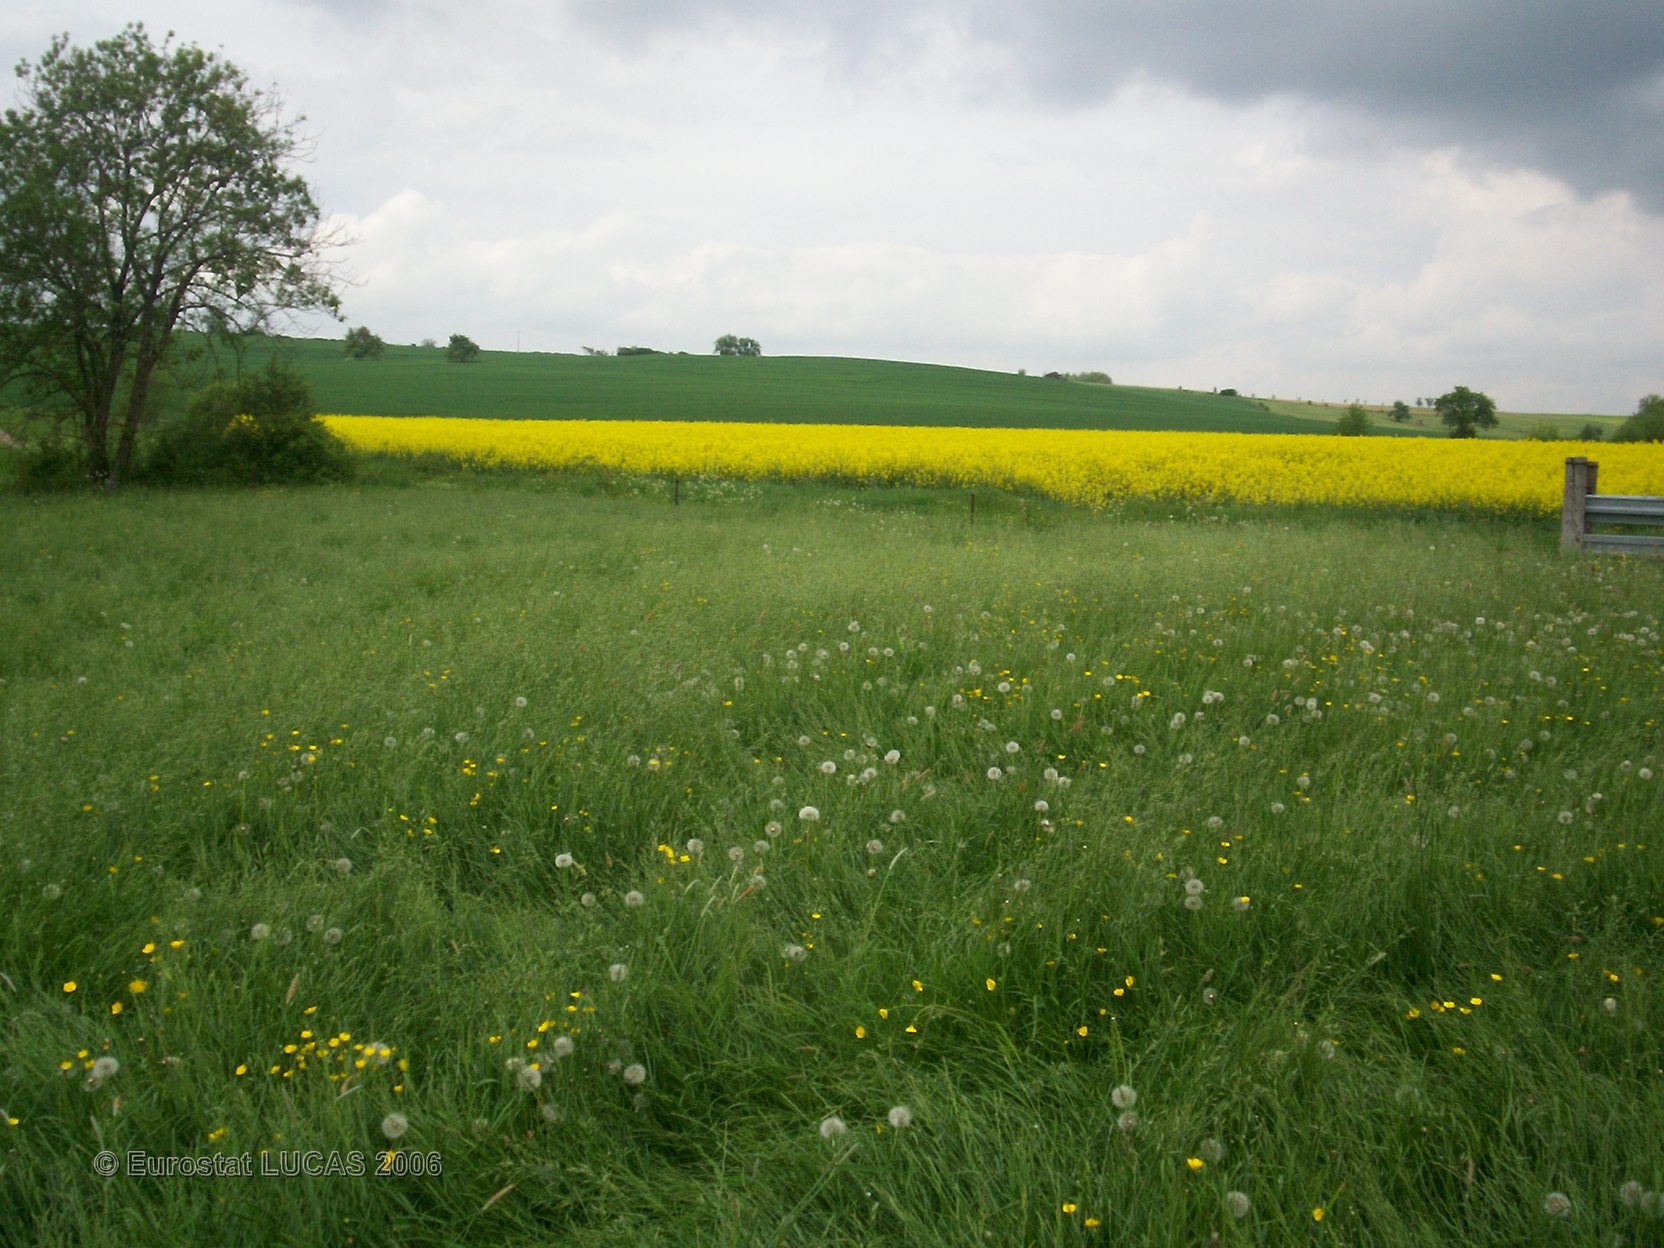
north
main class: Grassland
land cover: Grassland without tree/shrub cover
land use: Agriculture (excluding fallow land and kitchen gardens)
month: May
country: FR
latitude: 49.4083
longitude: 6.4302
